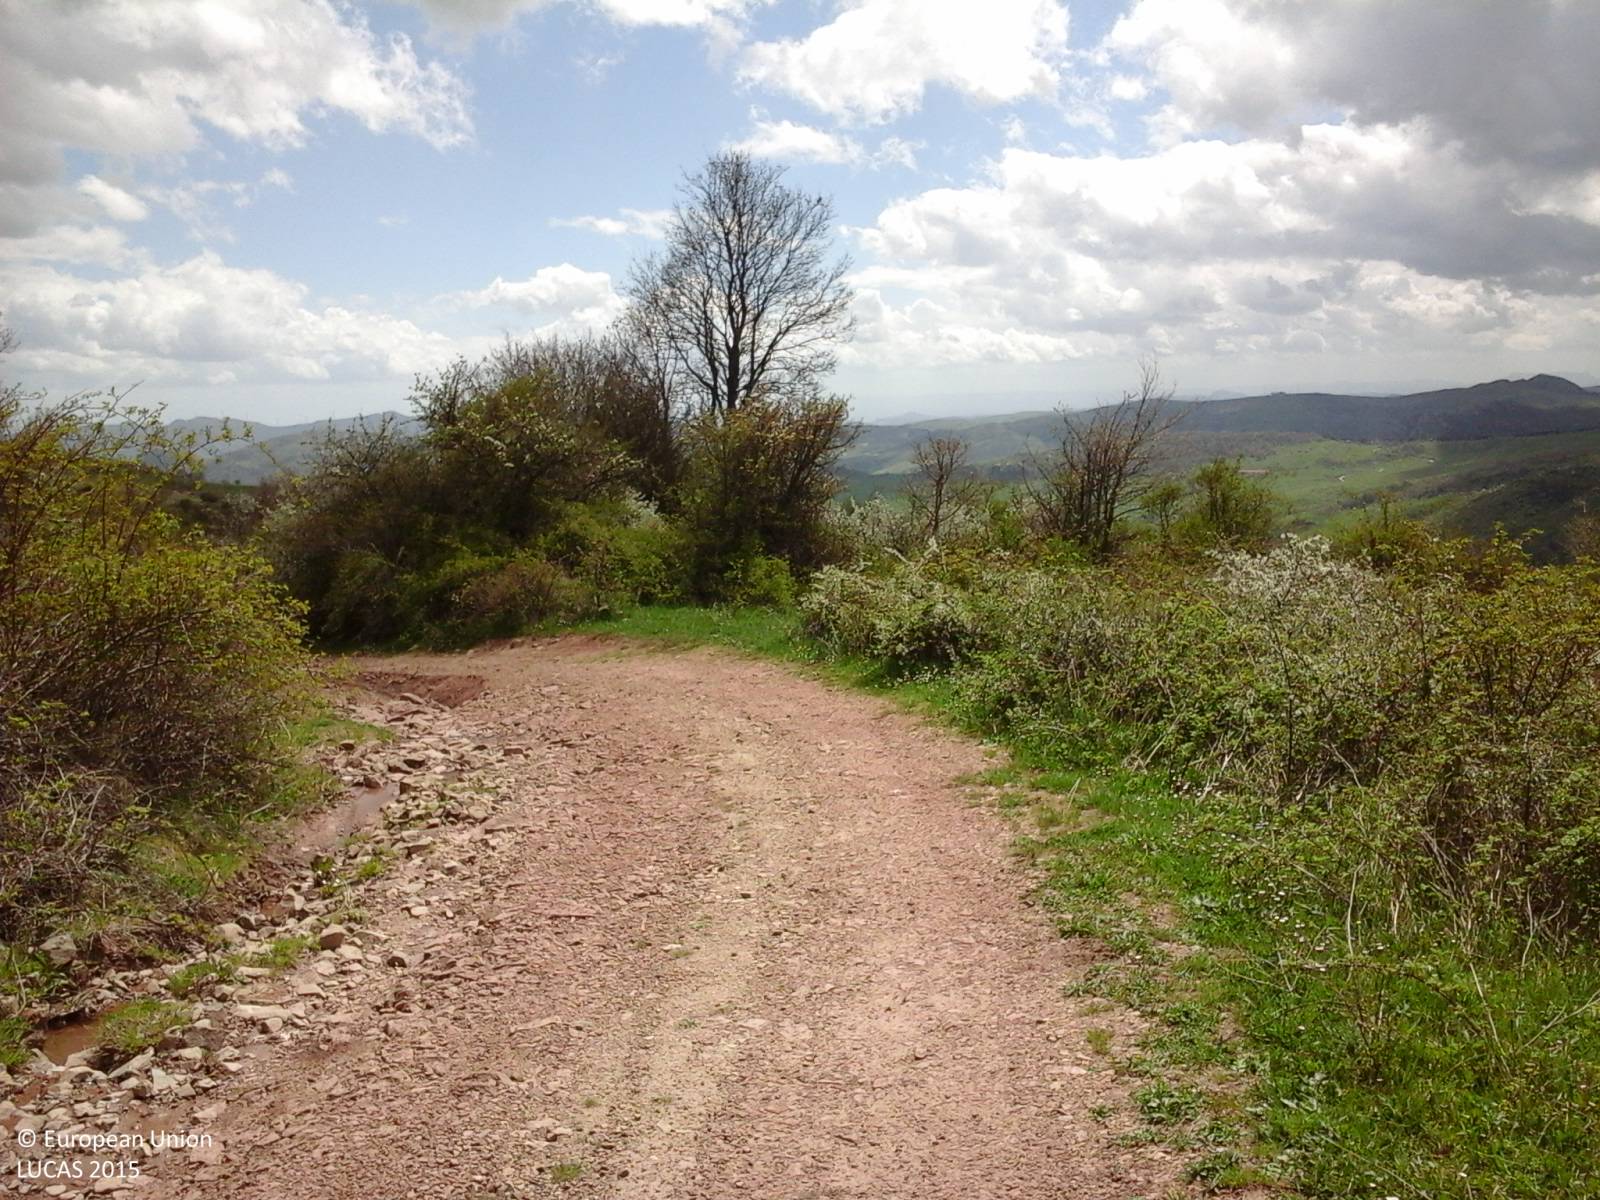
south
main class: Woodland
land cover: Broadleaved woodland
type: mesophytic deciduous forest
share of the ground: 50 - 75 %
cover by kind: broadleaved forest trees 70 %, herbaceous plants 20 %, shrubs 10 %
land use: Forestry
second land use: Amenities, museums, leisure
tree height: > 5 m
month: April
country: IT
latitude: 37.8727
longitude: 14.5951
